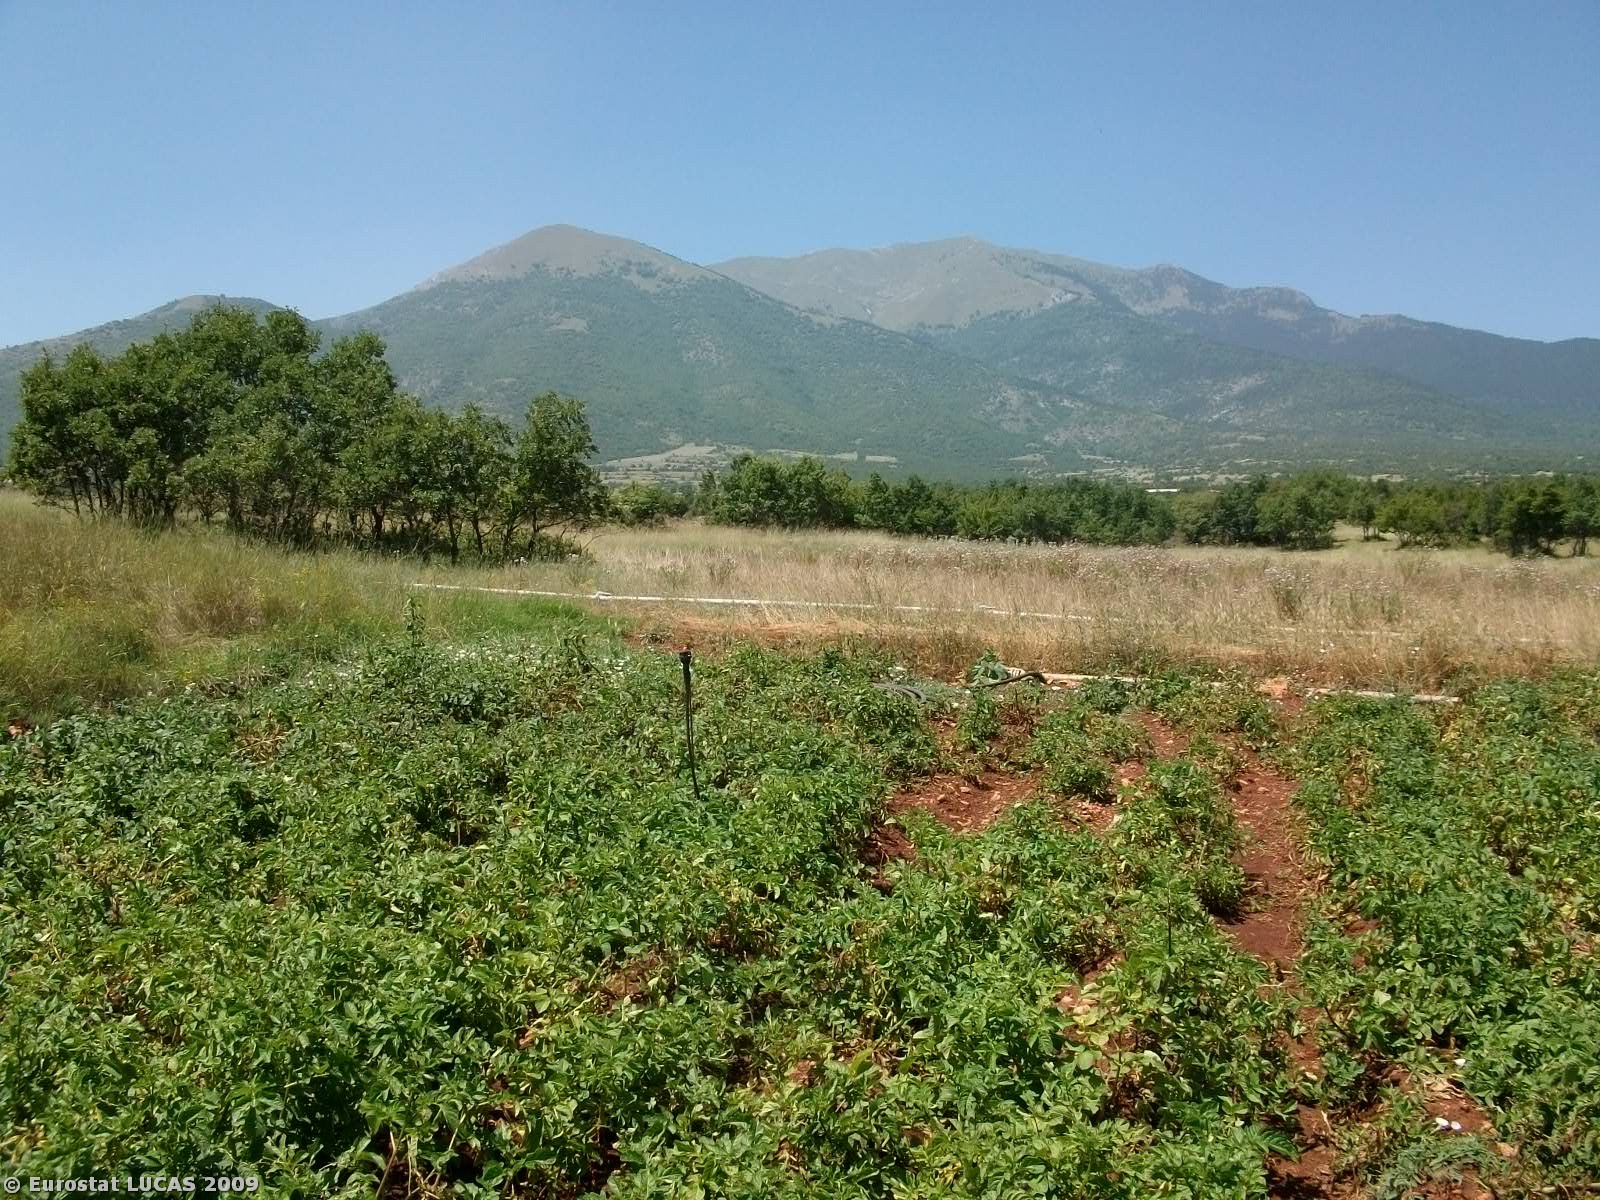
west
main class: Cropland
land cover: Potatoes
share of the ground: > 75 %
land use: Agriculture (excluding fallow land and kitchen gardens)
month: July
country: GR
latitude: 41.3685
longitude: 23.7145
